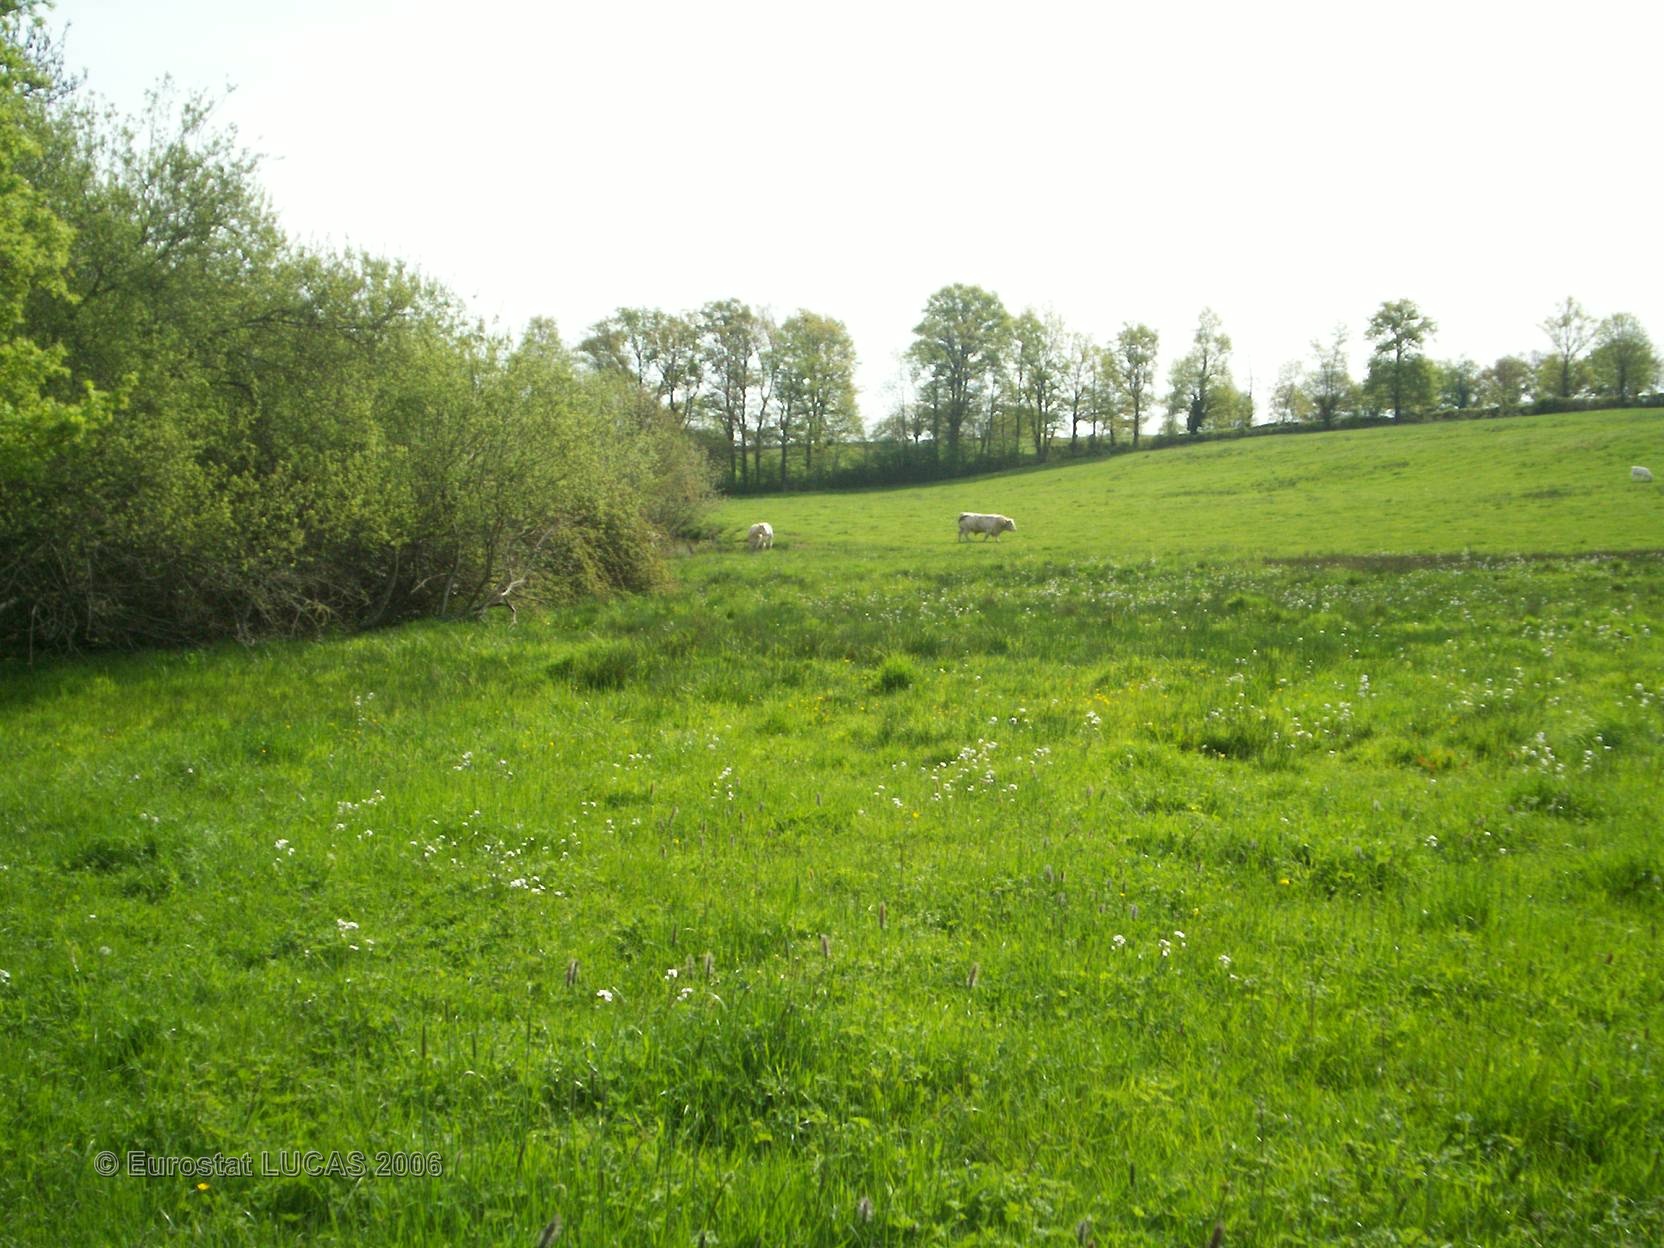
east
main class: Grassland
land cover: Grassland with sparse tree/shrub cover
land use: Agriculture (excluding fallow land and kitchen gardens)
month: May
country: FR
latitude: 46.3663
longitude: 3.1479
